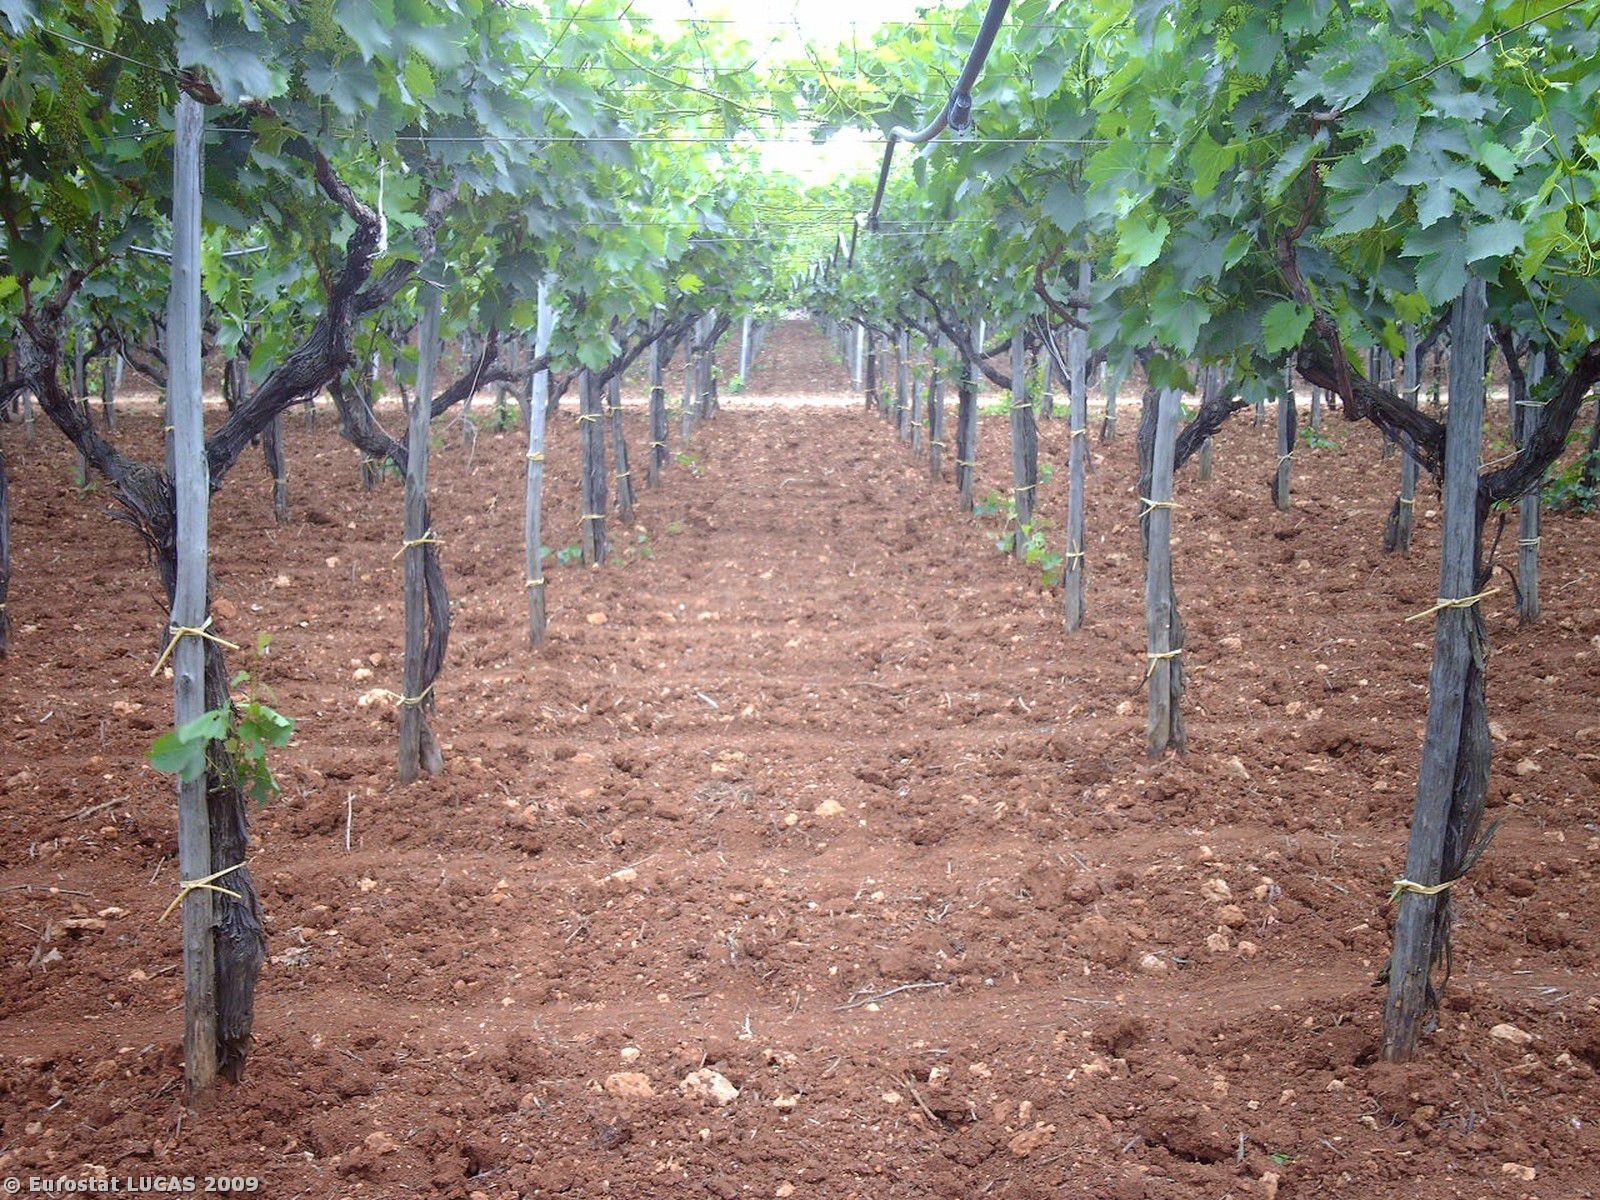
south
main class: Cropland
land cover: Vineyards
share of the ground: > 75 %
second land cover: Bare land
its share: 50 - 75 %
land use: Agriculture (excluding fallow land and kitchen gardens)
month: June
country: IT
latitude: 40.9430
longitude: 16.9984
